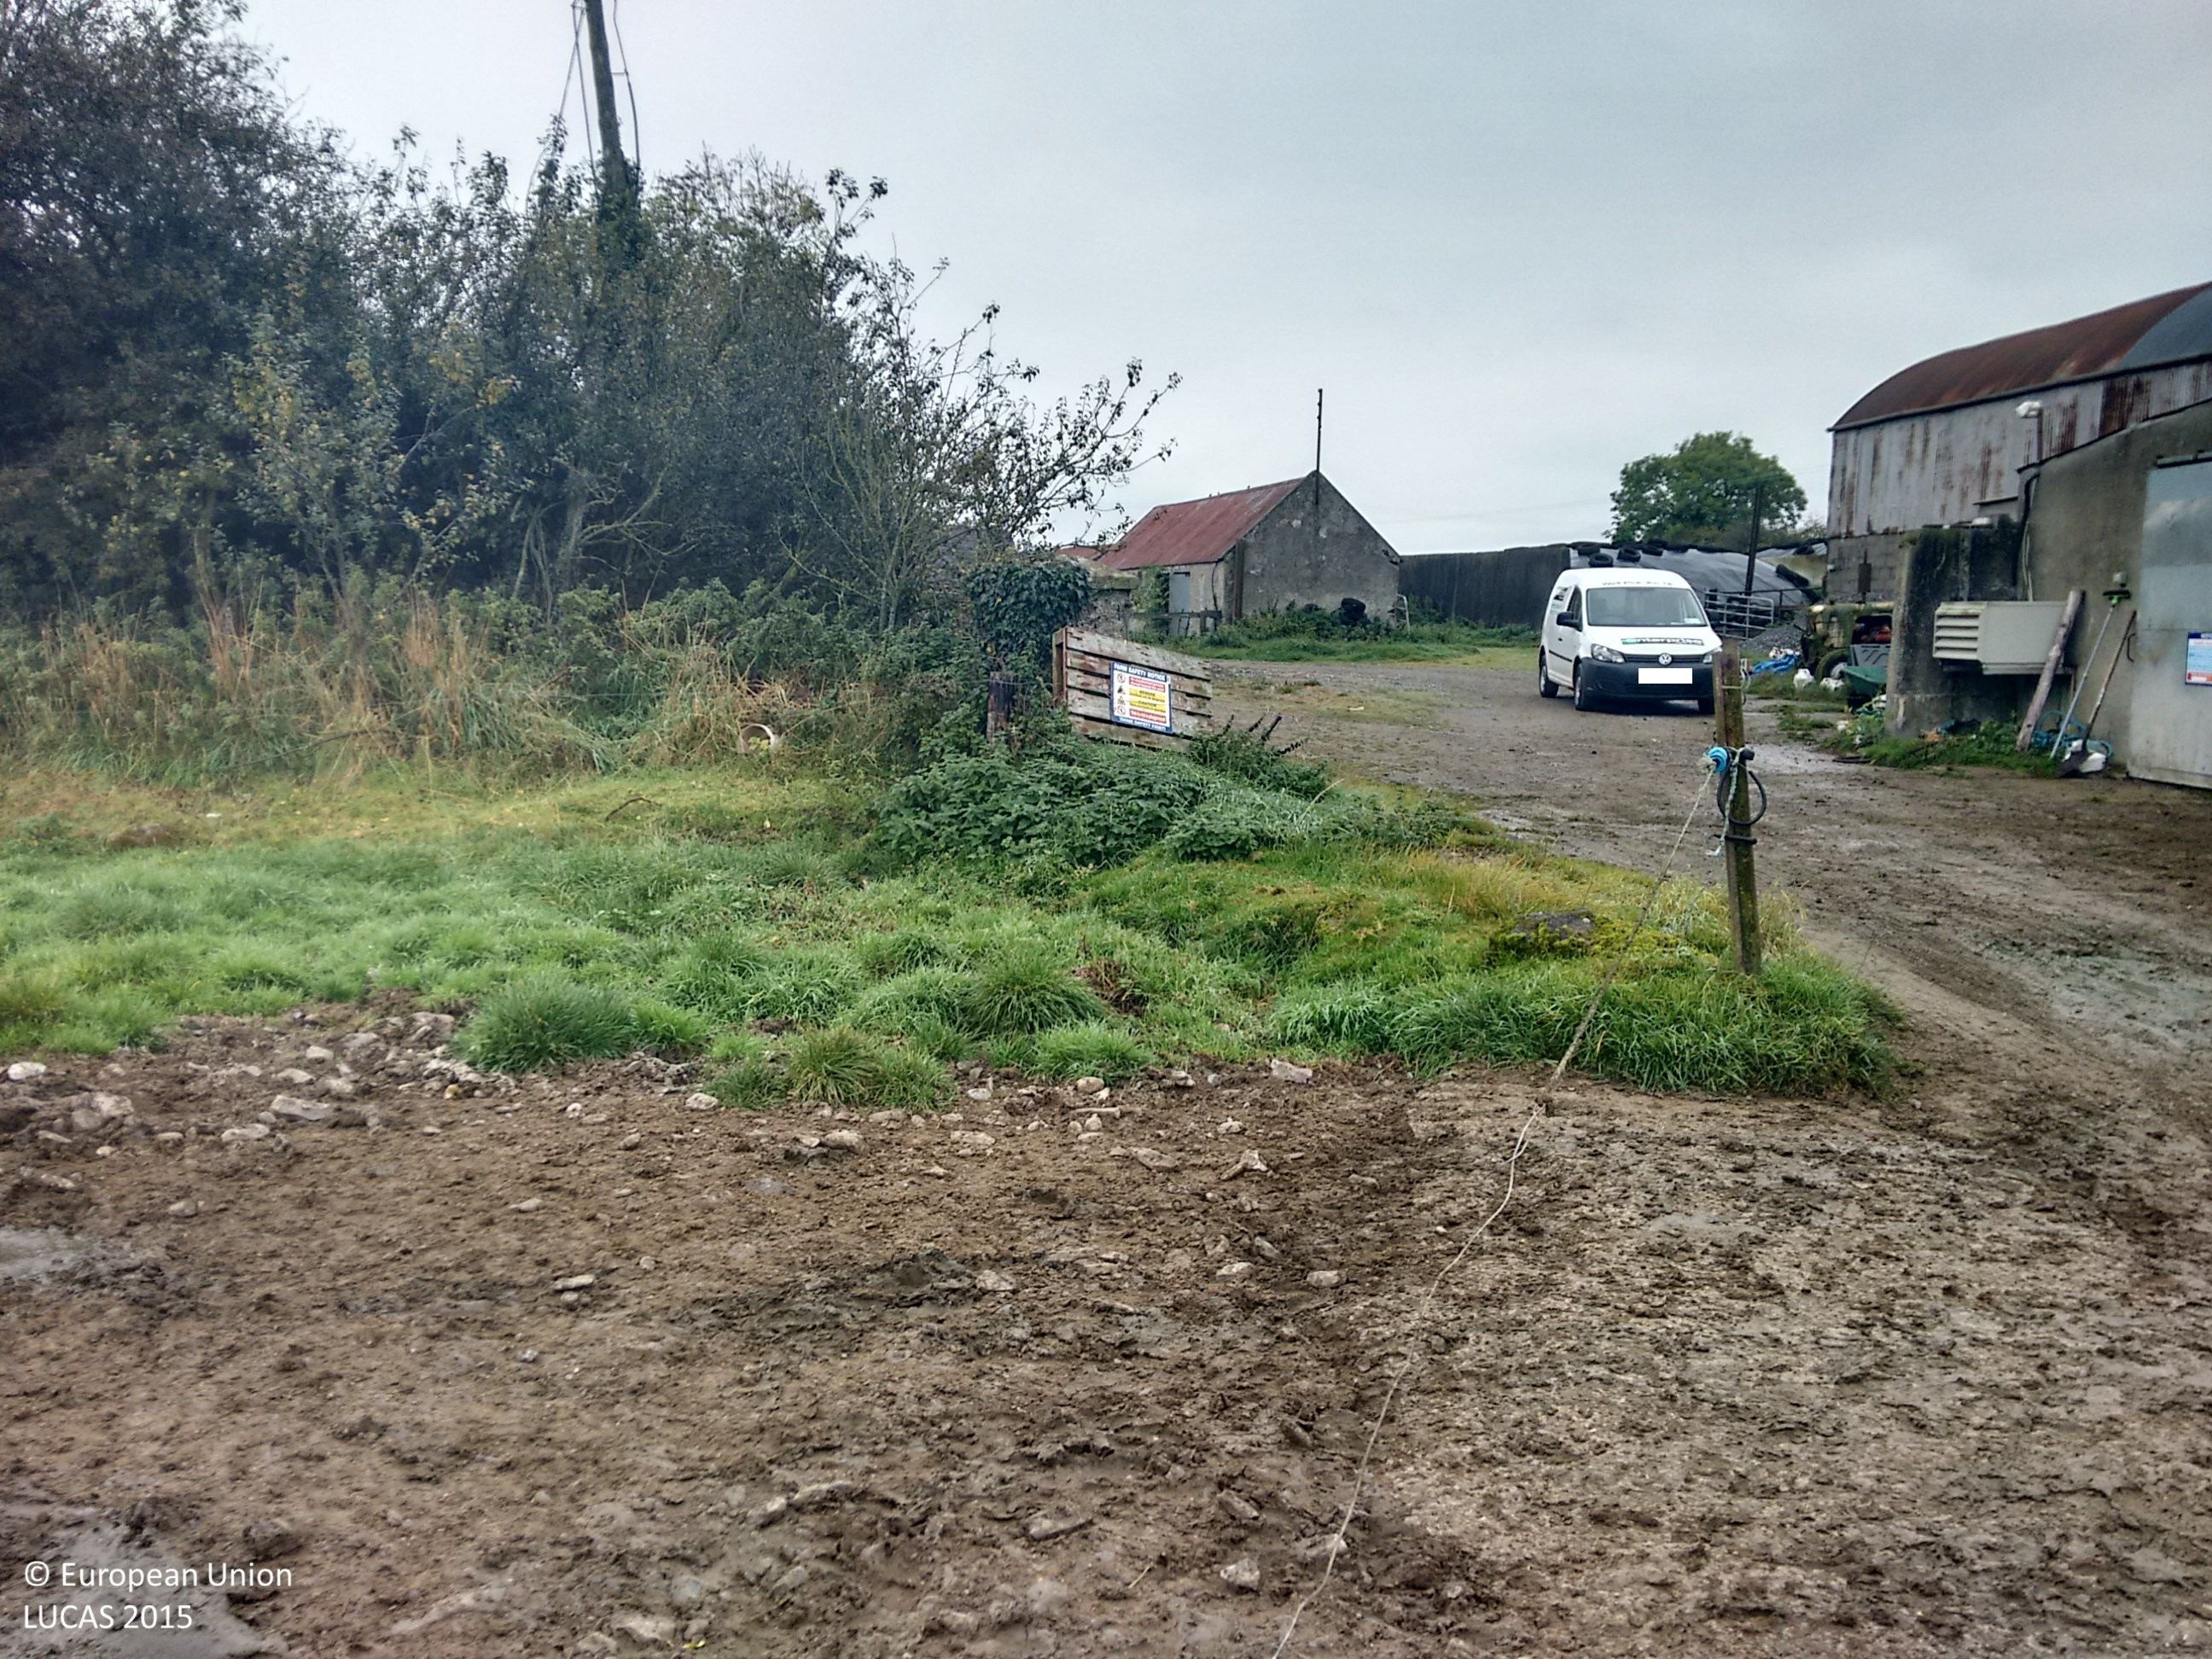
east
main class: Grassland
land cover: Grassland without tree/shrub cover
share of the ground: > 75 %
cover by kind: herbaceous plants 100 %
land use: Agriculture (excluding fallow land and kitchen gardens)
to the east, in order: Grassland without tree/shrub cover; Fences; Tracks; Fences; Abandoned hedges; Grassland without tree/shrub cover; Electric lines; Grassland without tree/shrub cover; Electric lines; Managed hedges; Permanent crops (only in case pi)
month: October
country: IE
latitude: 52.6477
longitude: -7.7409
